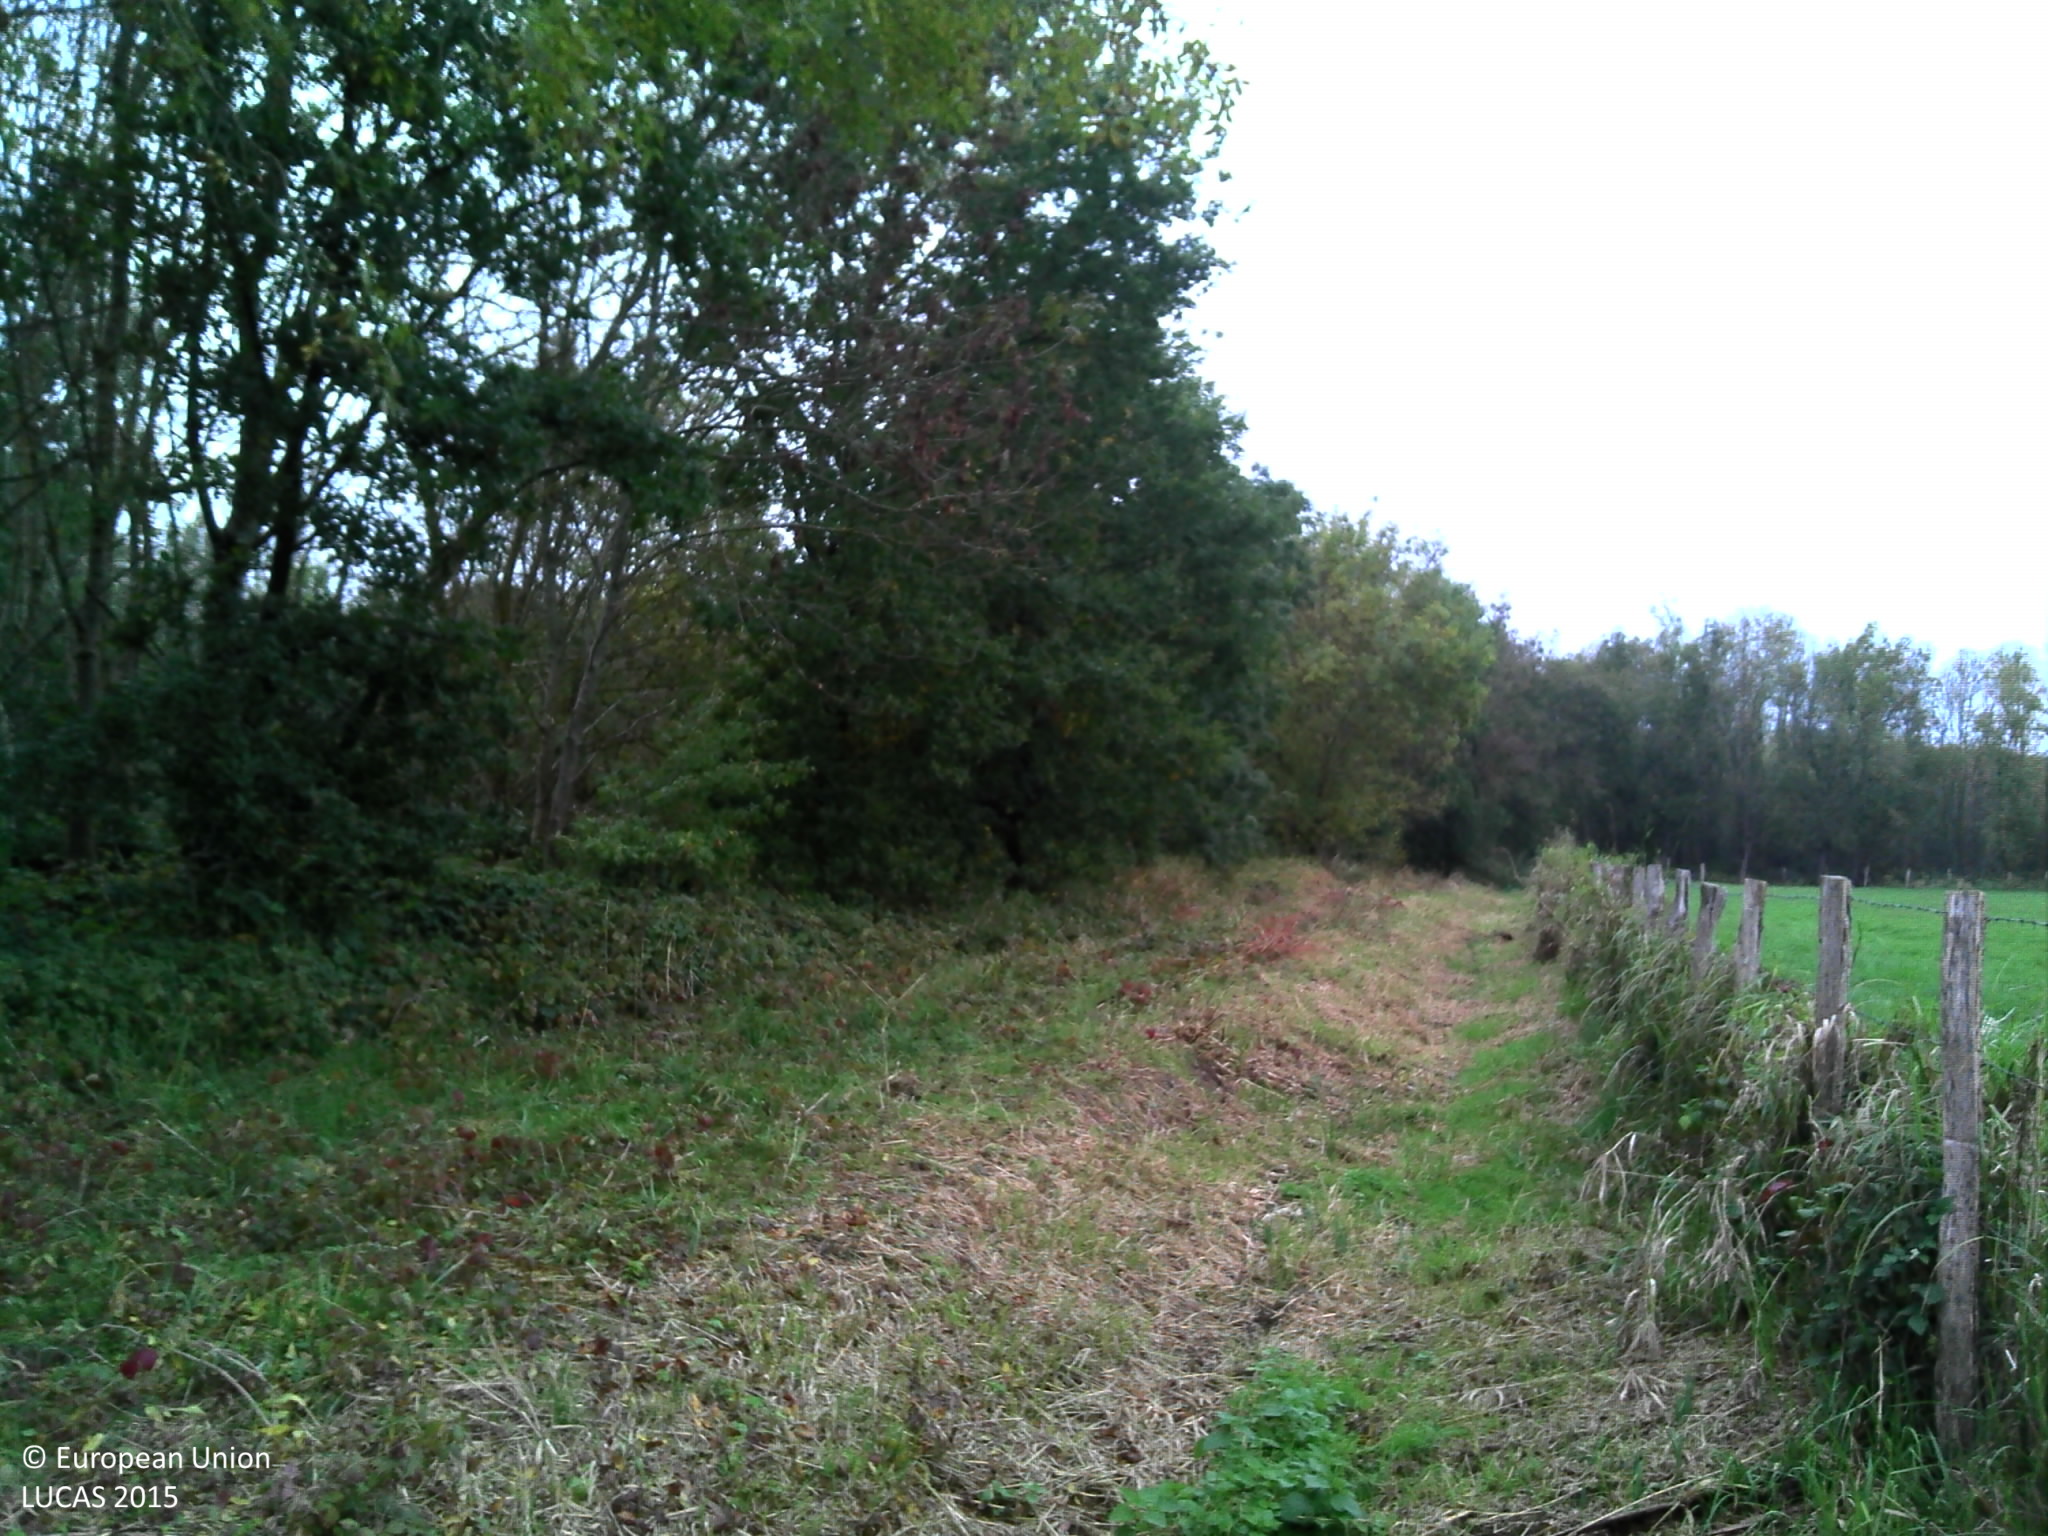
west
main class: Grassland
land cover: Grassland without tree/shrub cover
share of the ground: > 75 %
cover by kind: herbaceous plants 100 %
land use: Agriculture (excluding fallow land and kitchen gardens)
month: October
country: FR
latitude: 46.2070
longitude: 4.8052
